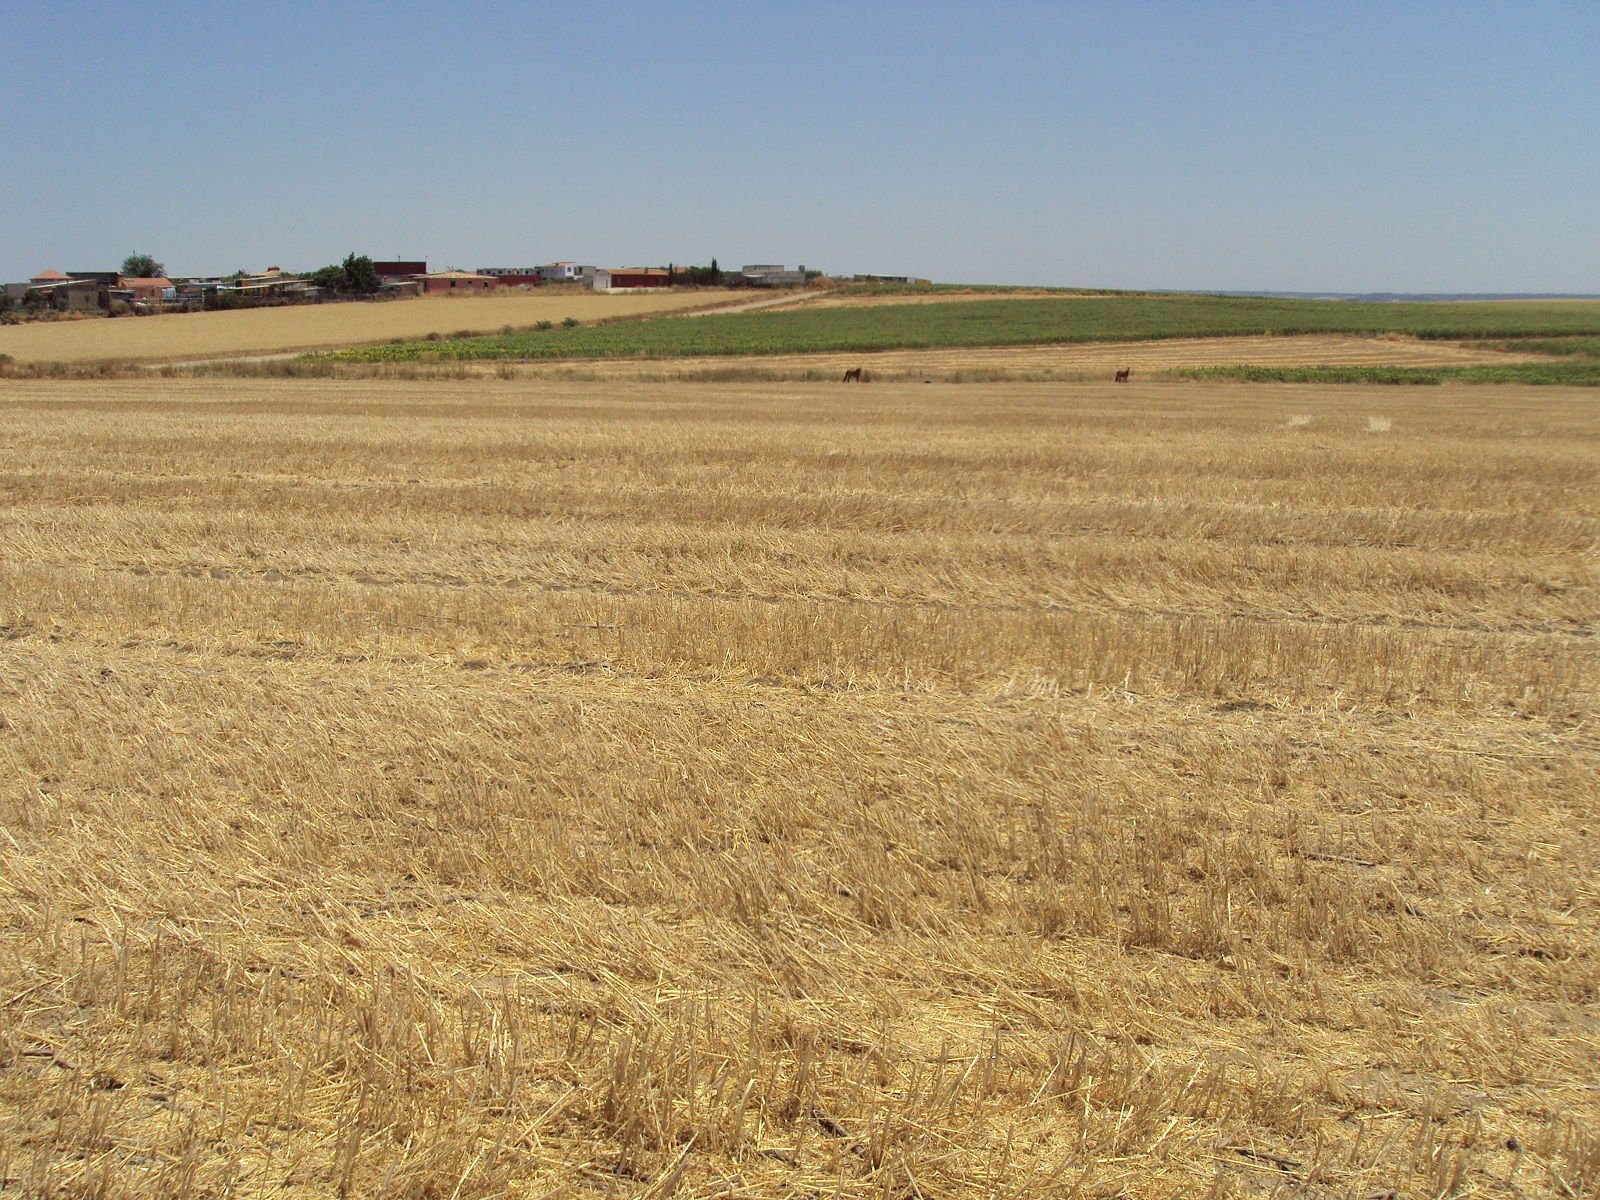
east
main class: Cropland
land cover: Durum wheat
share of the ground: > 75 %
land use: Agriculture (excluding fallow land and kitchen gardens)
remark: Harvested field
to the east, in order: Durum wheat; Grass margins; Rivers and streams; Grass margins; Durum wheat; Grass margins; Sunflower
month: June
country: ES
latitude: 37.3333
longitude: -6.8893
